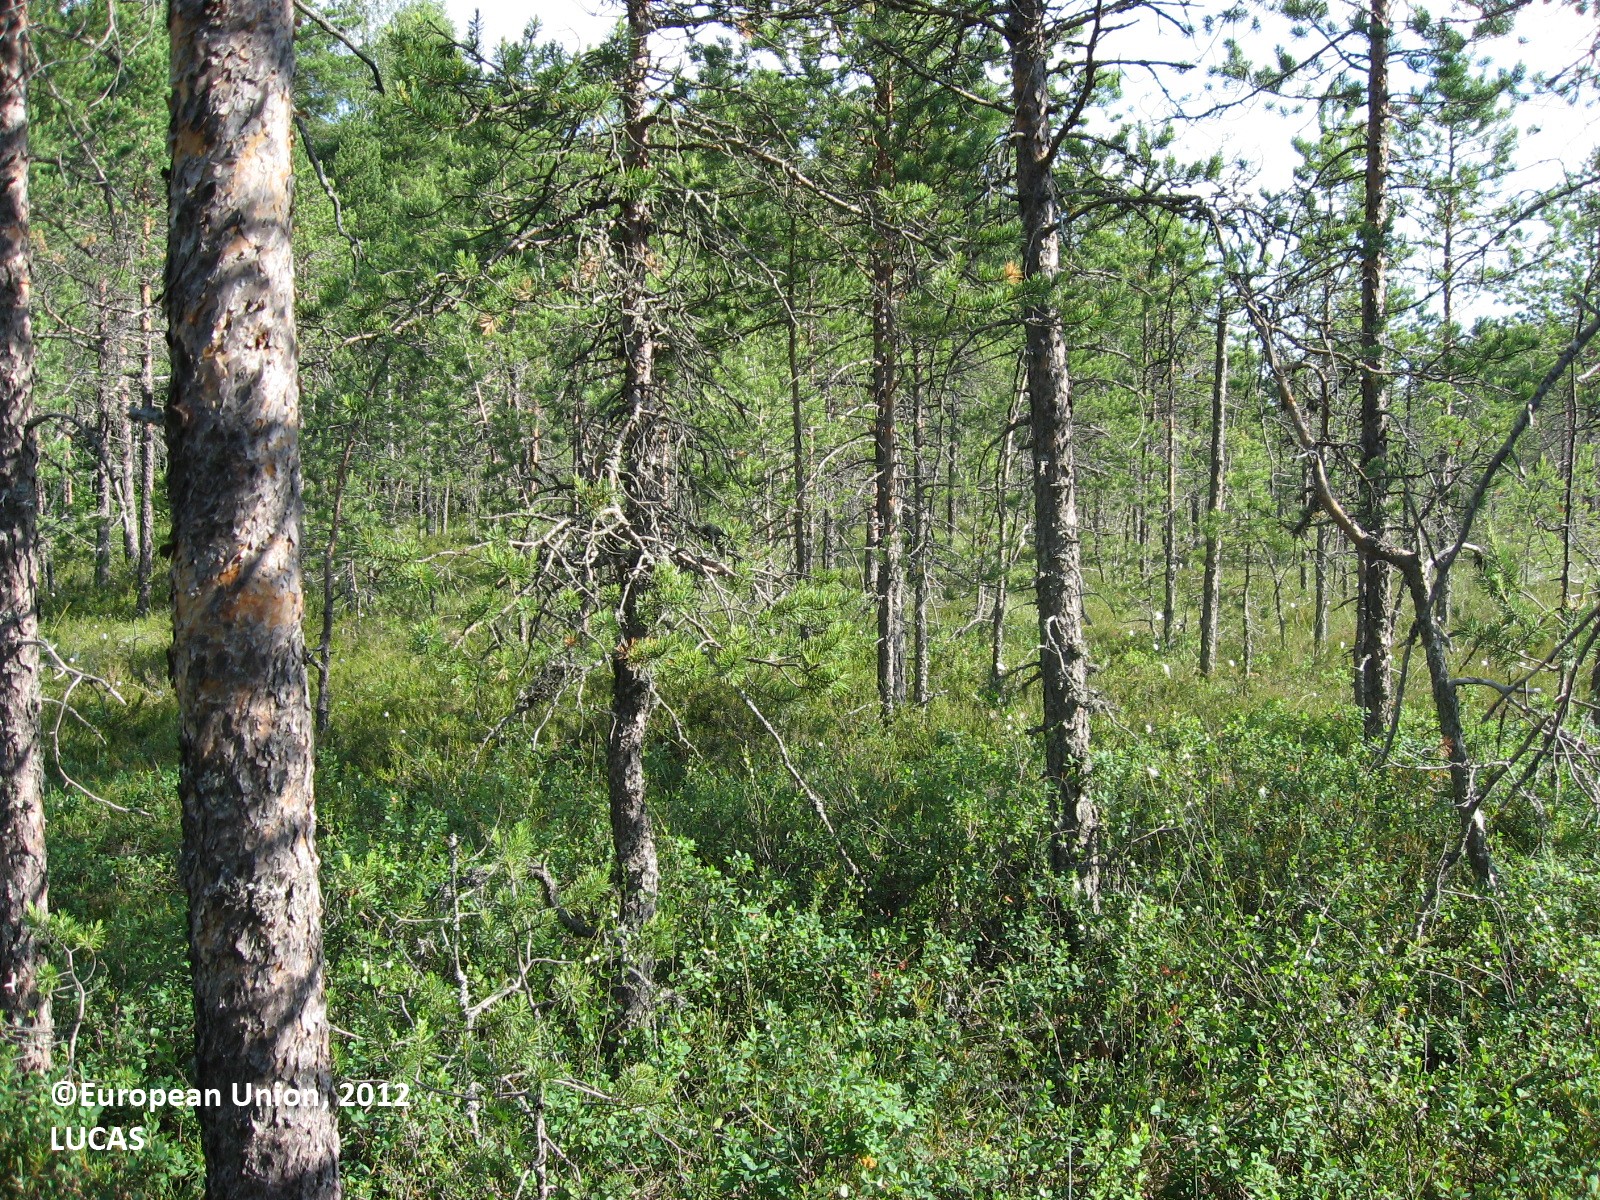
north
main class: Woodland
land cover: Pine dominated coniferous woodland
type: boreal forest
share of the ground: 25 - 50 %
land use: Forestry
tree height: < 5 m
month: July
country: FI
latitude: 60.8661
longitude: 26.4474
